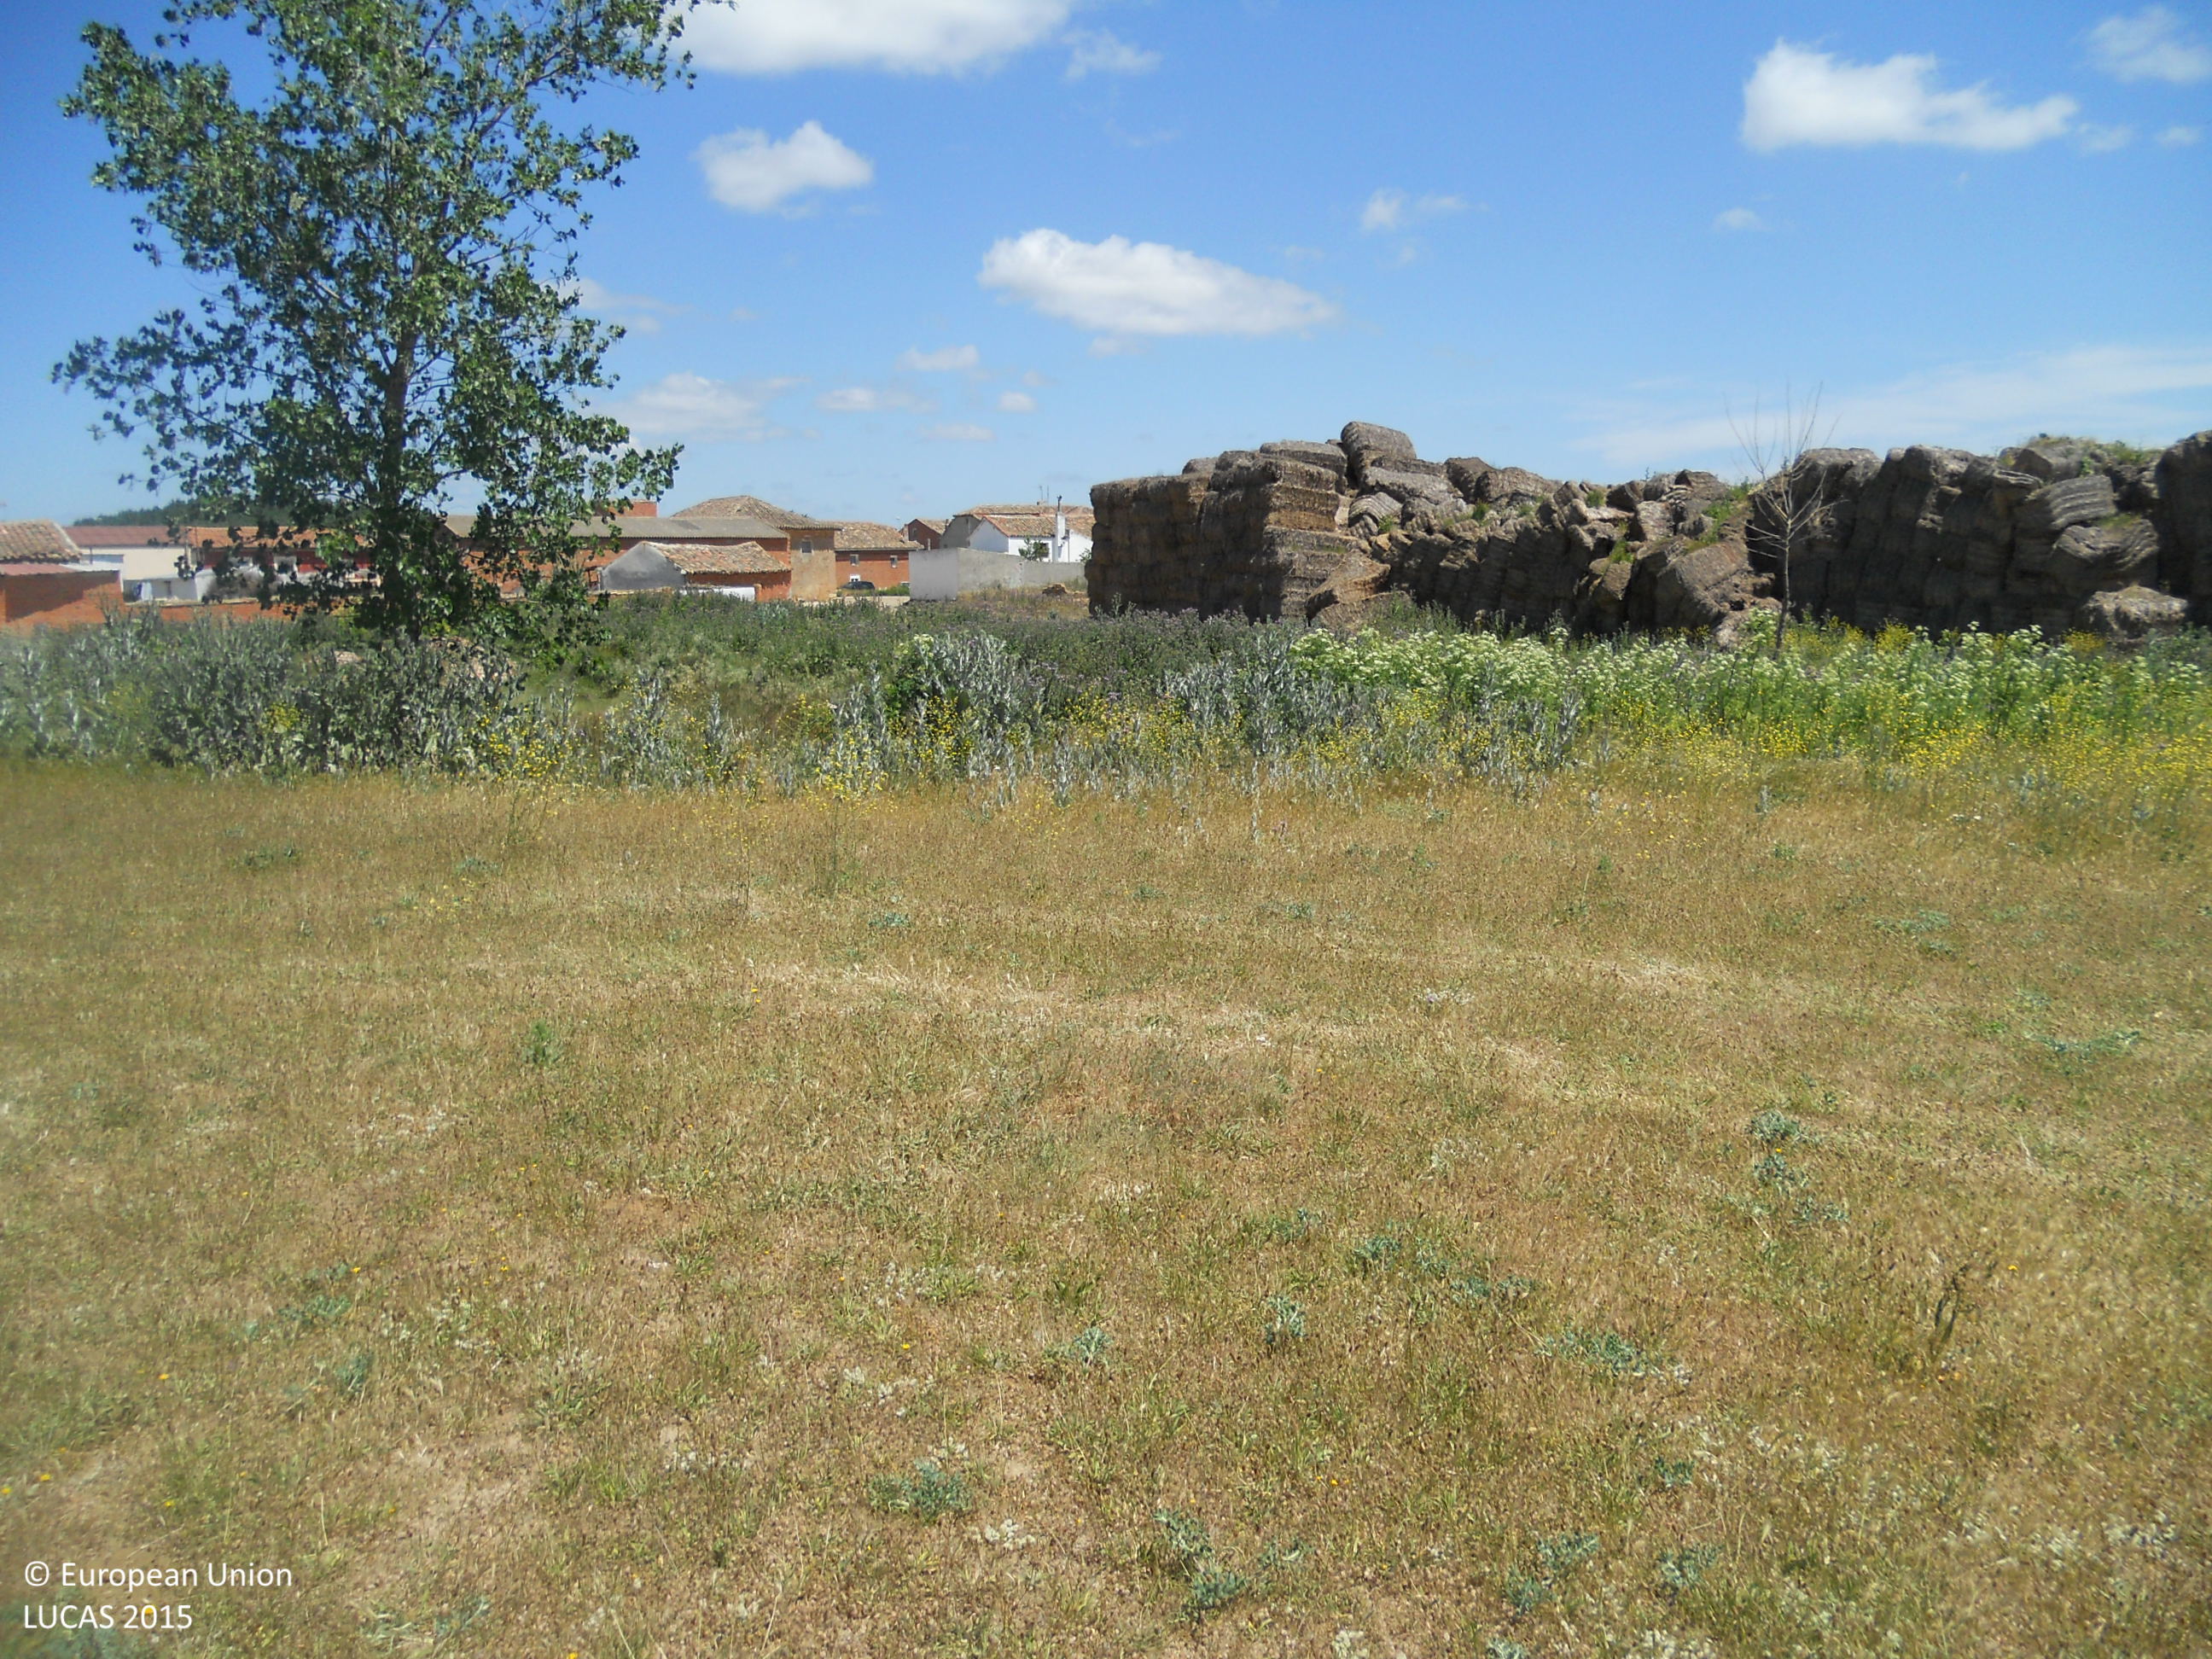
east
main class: Grassland
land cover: Grassland without tree/shrub cover
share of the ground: > 75 %
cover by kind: herbaceous plants 100 %
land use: Agriculture (excluding fallow land and kitchen gardens)
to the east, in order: Grassland without tree/shrub cover; Single bushes/trees; Grassland without tree/shrub cover; Tracks; Grassland without tree/shrub cover; Tracks; Grassland without tree/shrub cover; Artificial constructions in urban areas
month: May
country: ES
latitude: 42.3565
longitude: -4.2376
